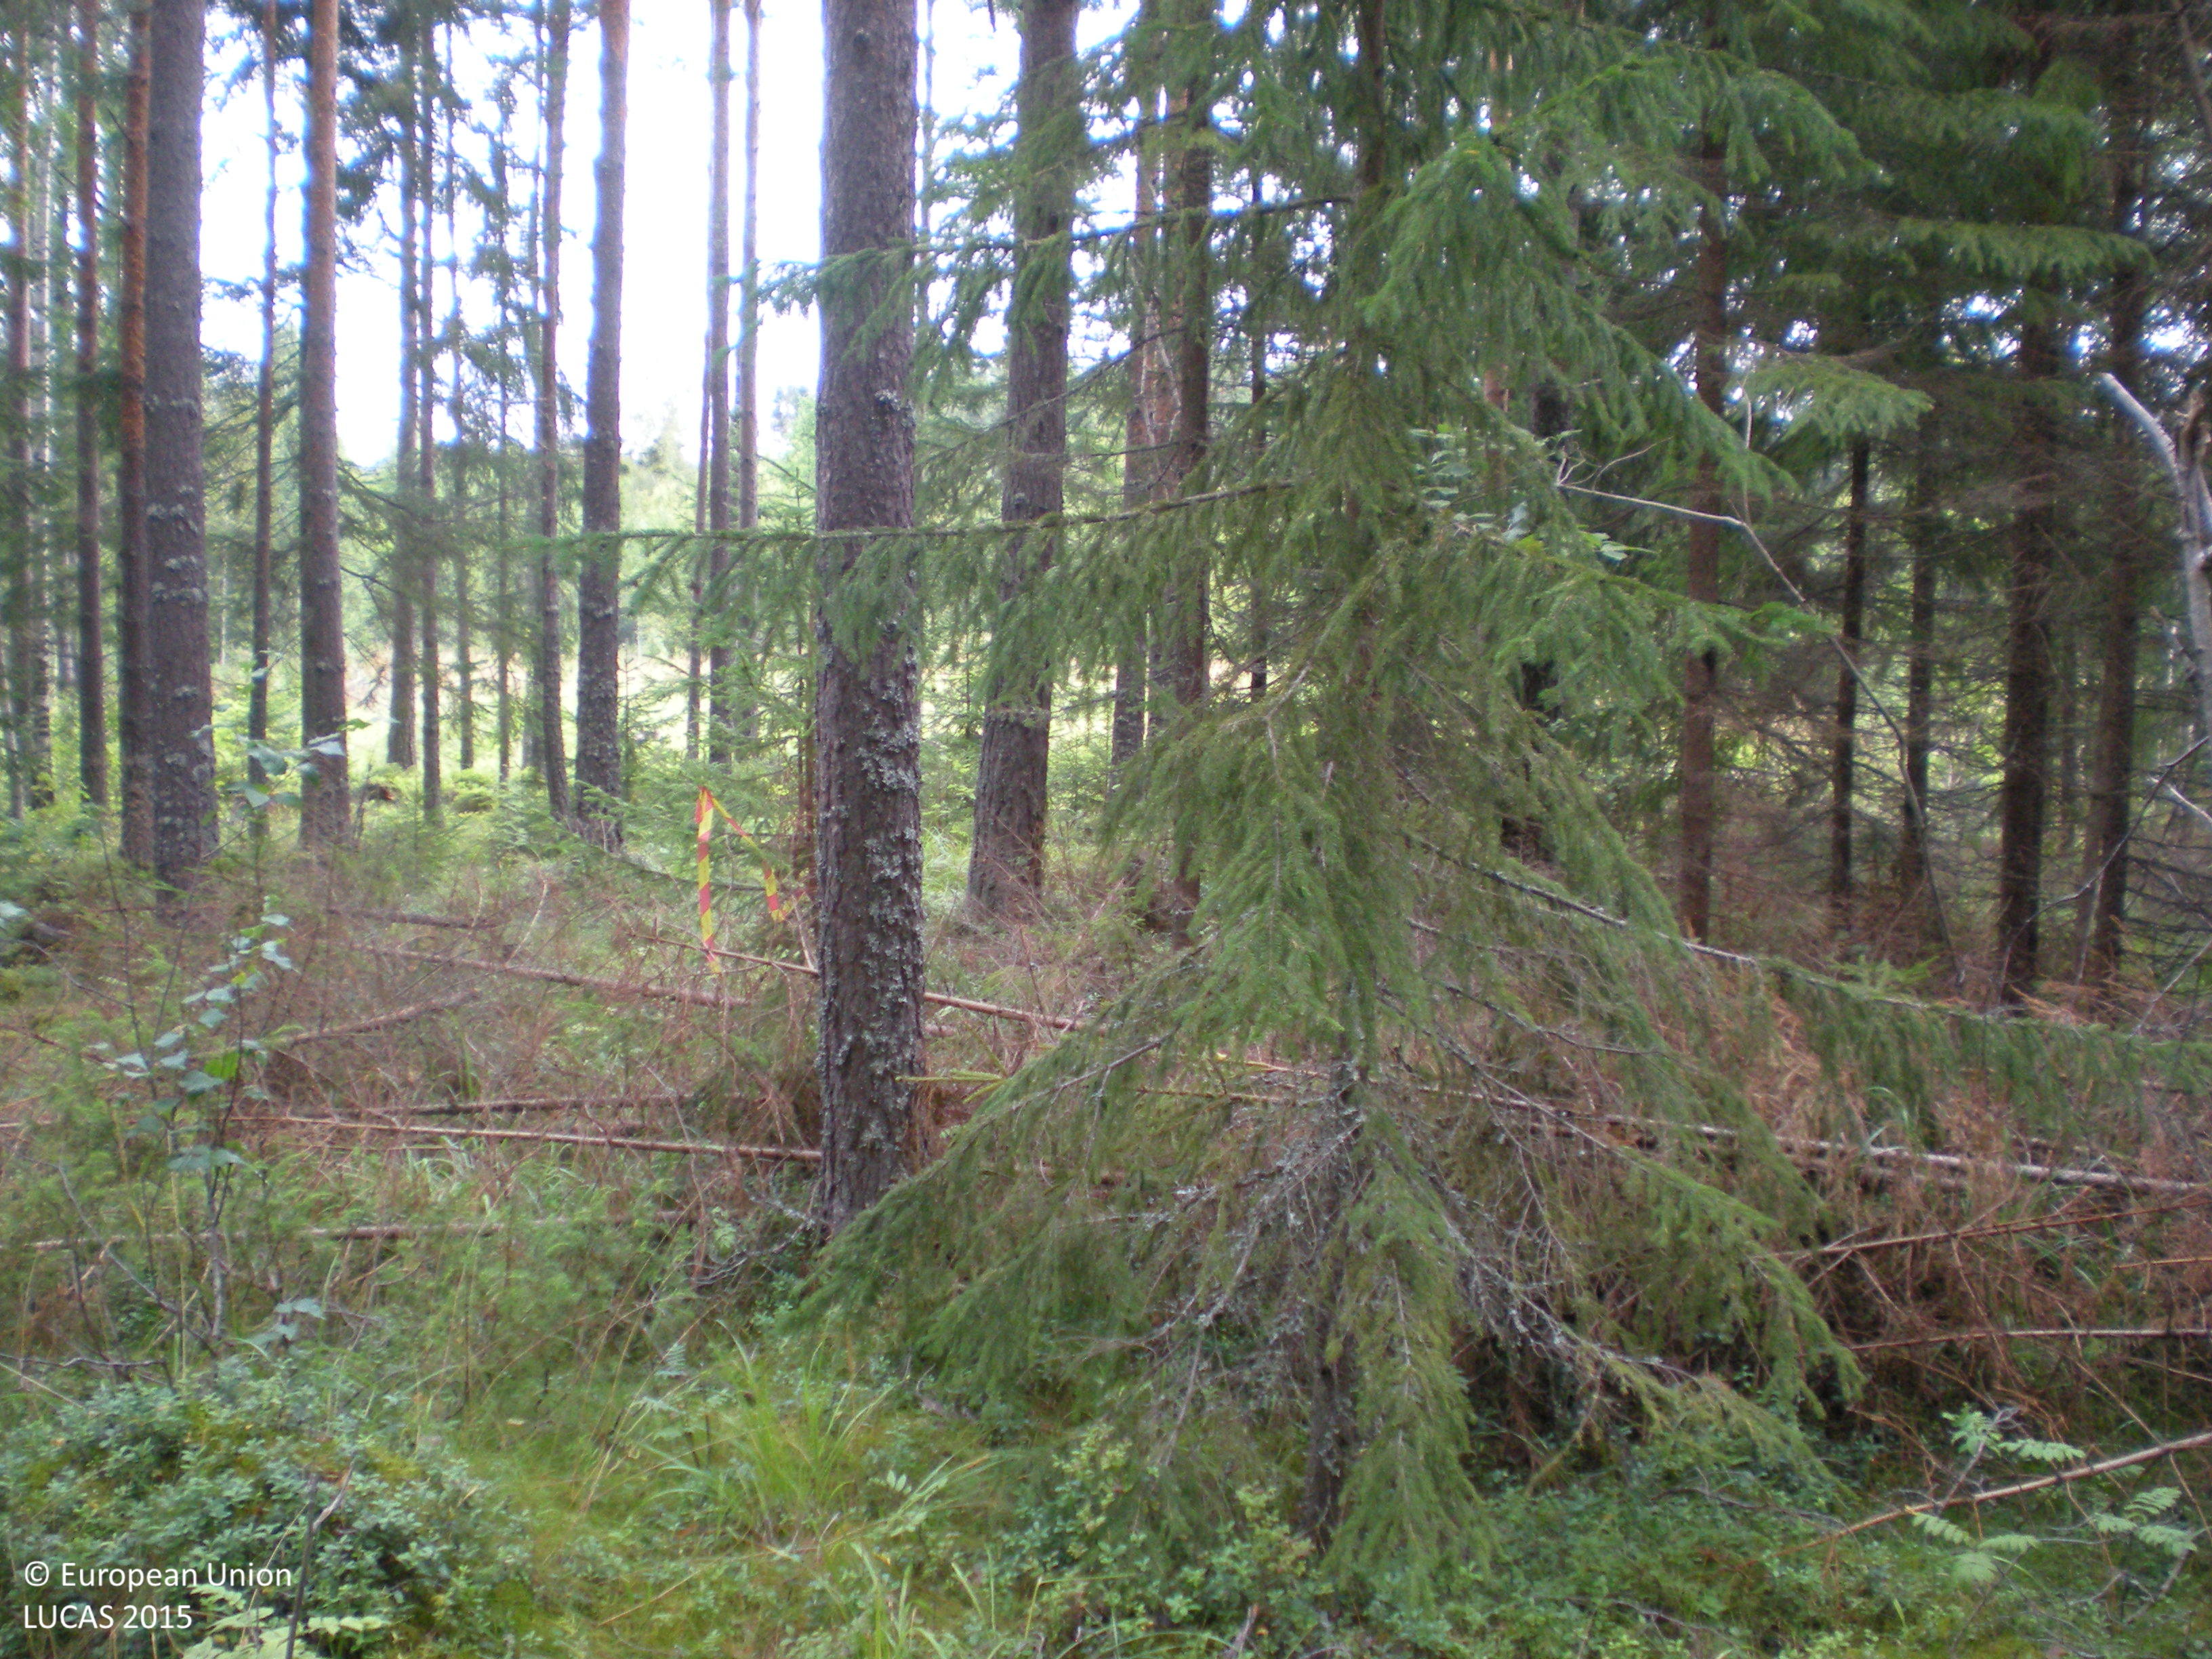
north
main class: Woodland
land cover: Other coniferous woodland
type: boreal forest
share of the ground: 50 - 75 %
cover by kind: coniferous forest trees 70 %, shrubs 15 %, broadleaved forest trees 5 %, herbaceous plants 5 %, lichens and mosses 5 %
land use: Forestry
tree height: > 5 m
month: August
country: SE
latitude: 60.5059
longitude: 17.1459
